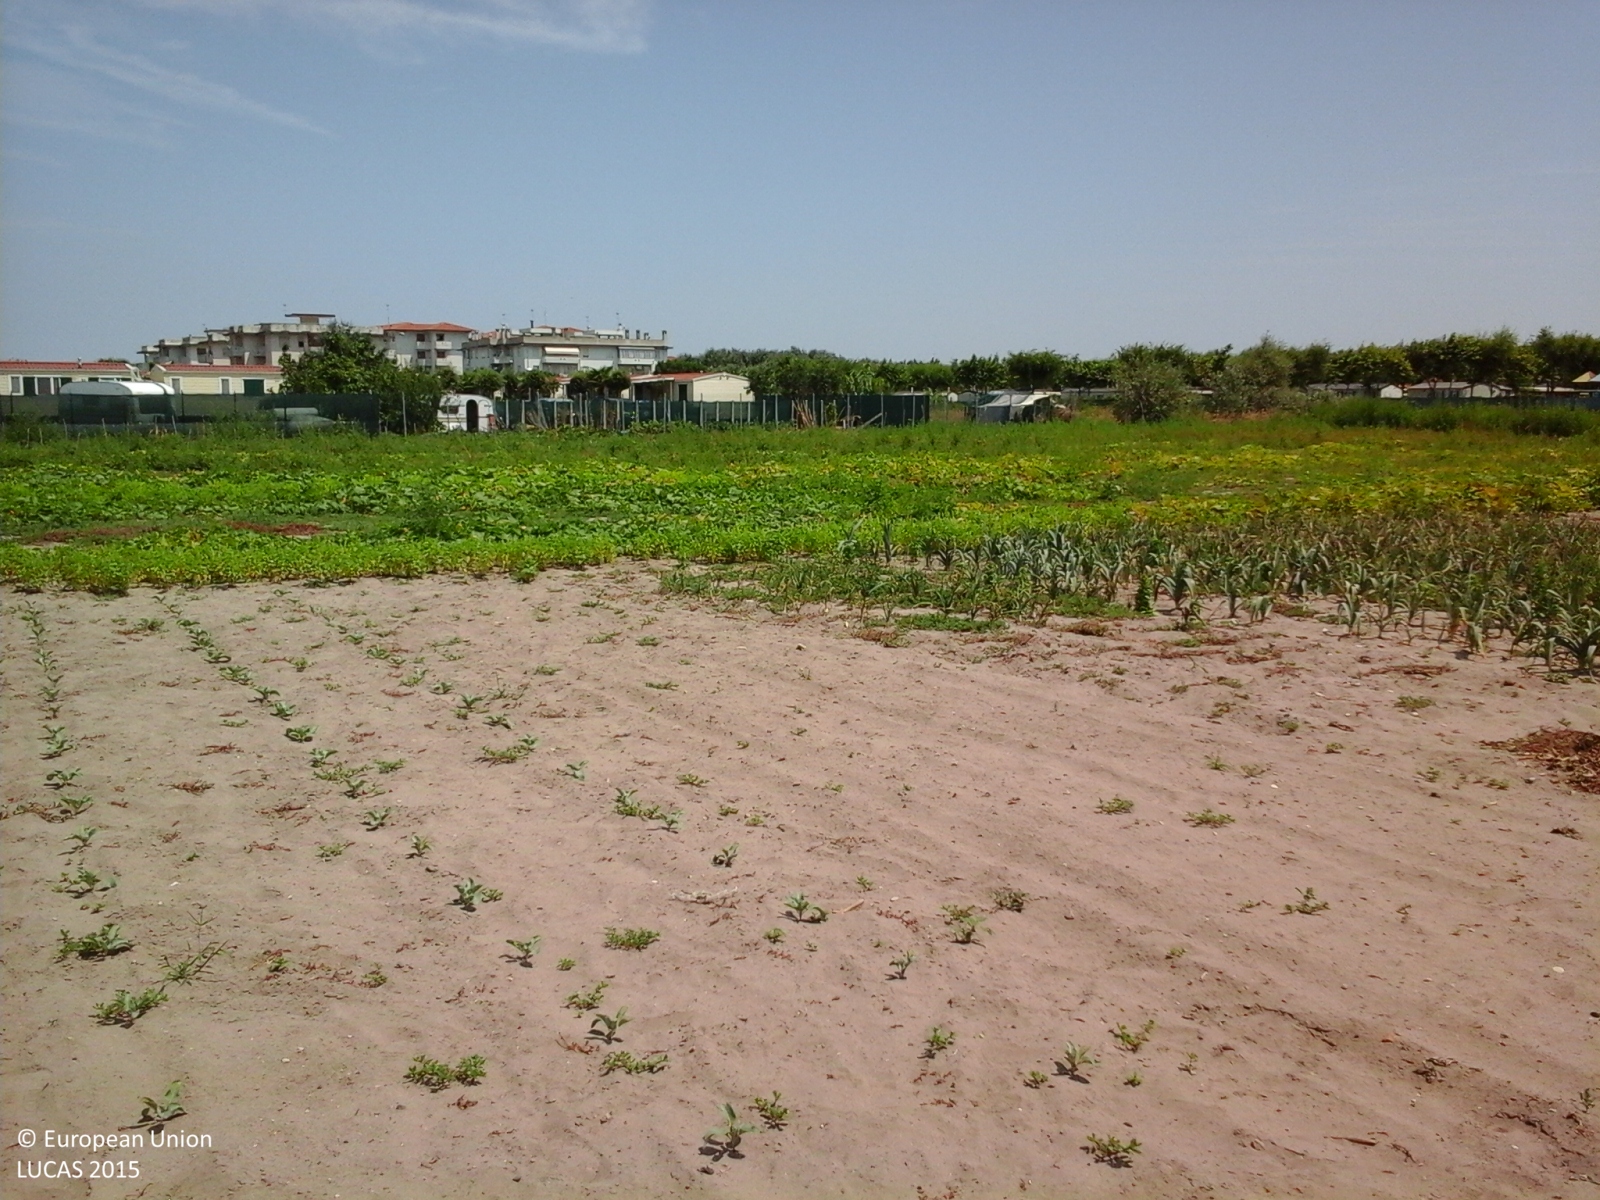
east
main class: Cropland
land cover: Other fresh vegetables
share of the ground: 10 - 25 %
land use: Agriculture (excluding fallow land and kitchen gardens)
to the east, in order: Other fresh vegetables; Spontaneously vegetated surfaces; Artificial constructions in urban areas; Shrubland without tree cover; Grassland without tree/shrub cover; Ditches and canals; Spontaneously vegetated surfaces; Artificial constructions in urban areas
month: July
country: IT
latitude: 45.1909
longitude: 12.2999
